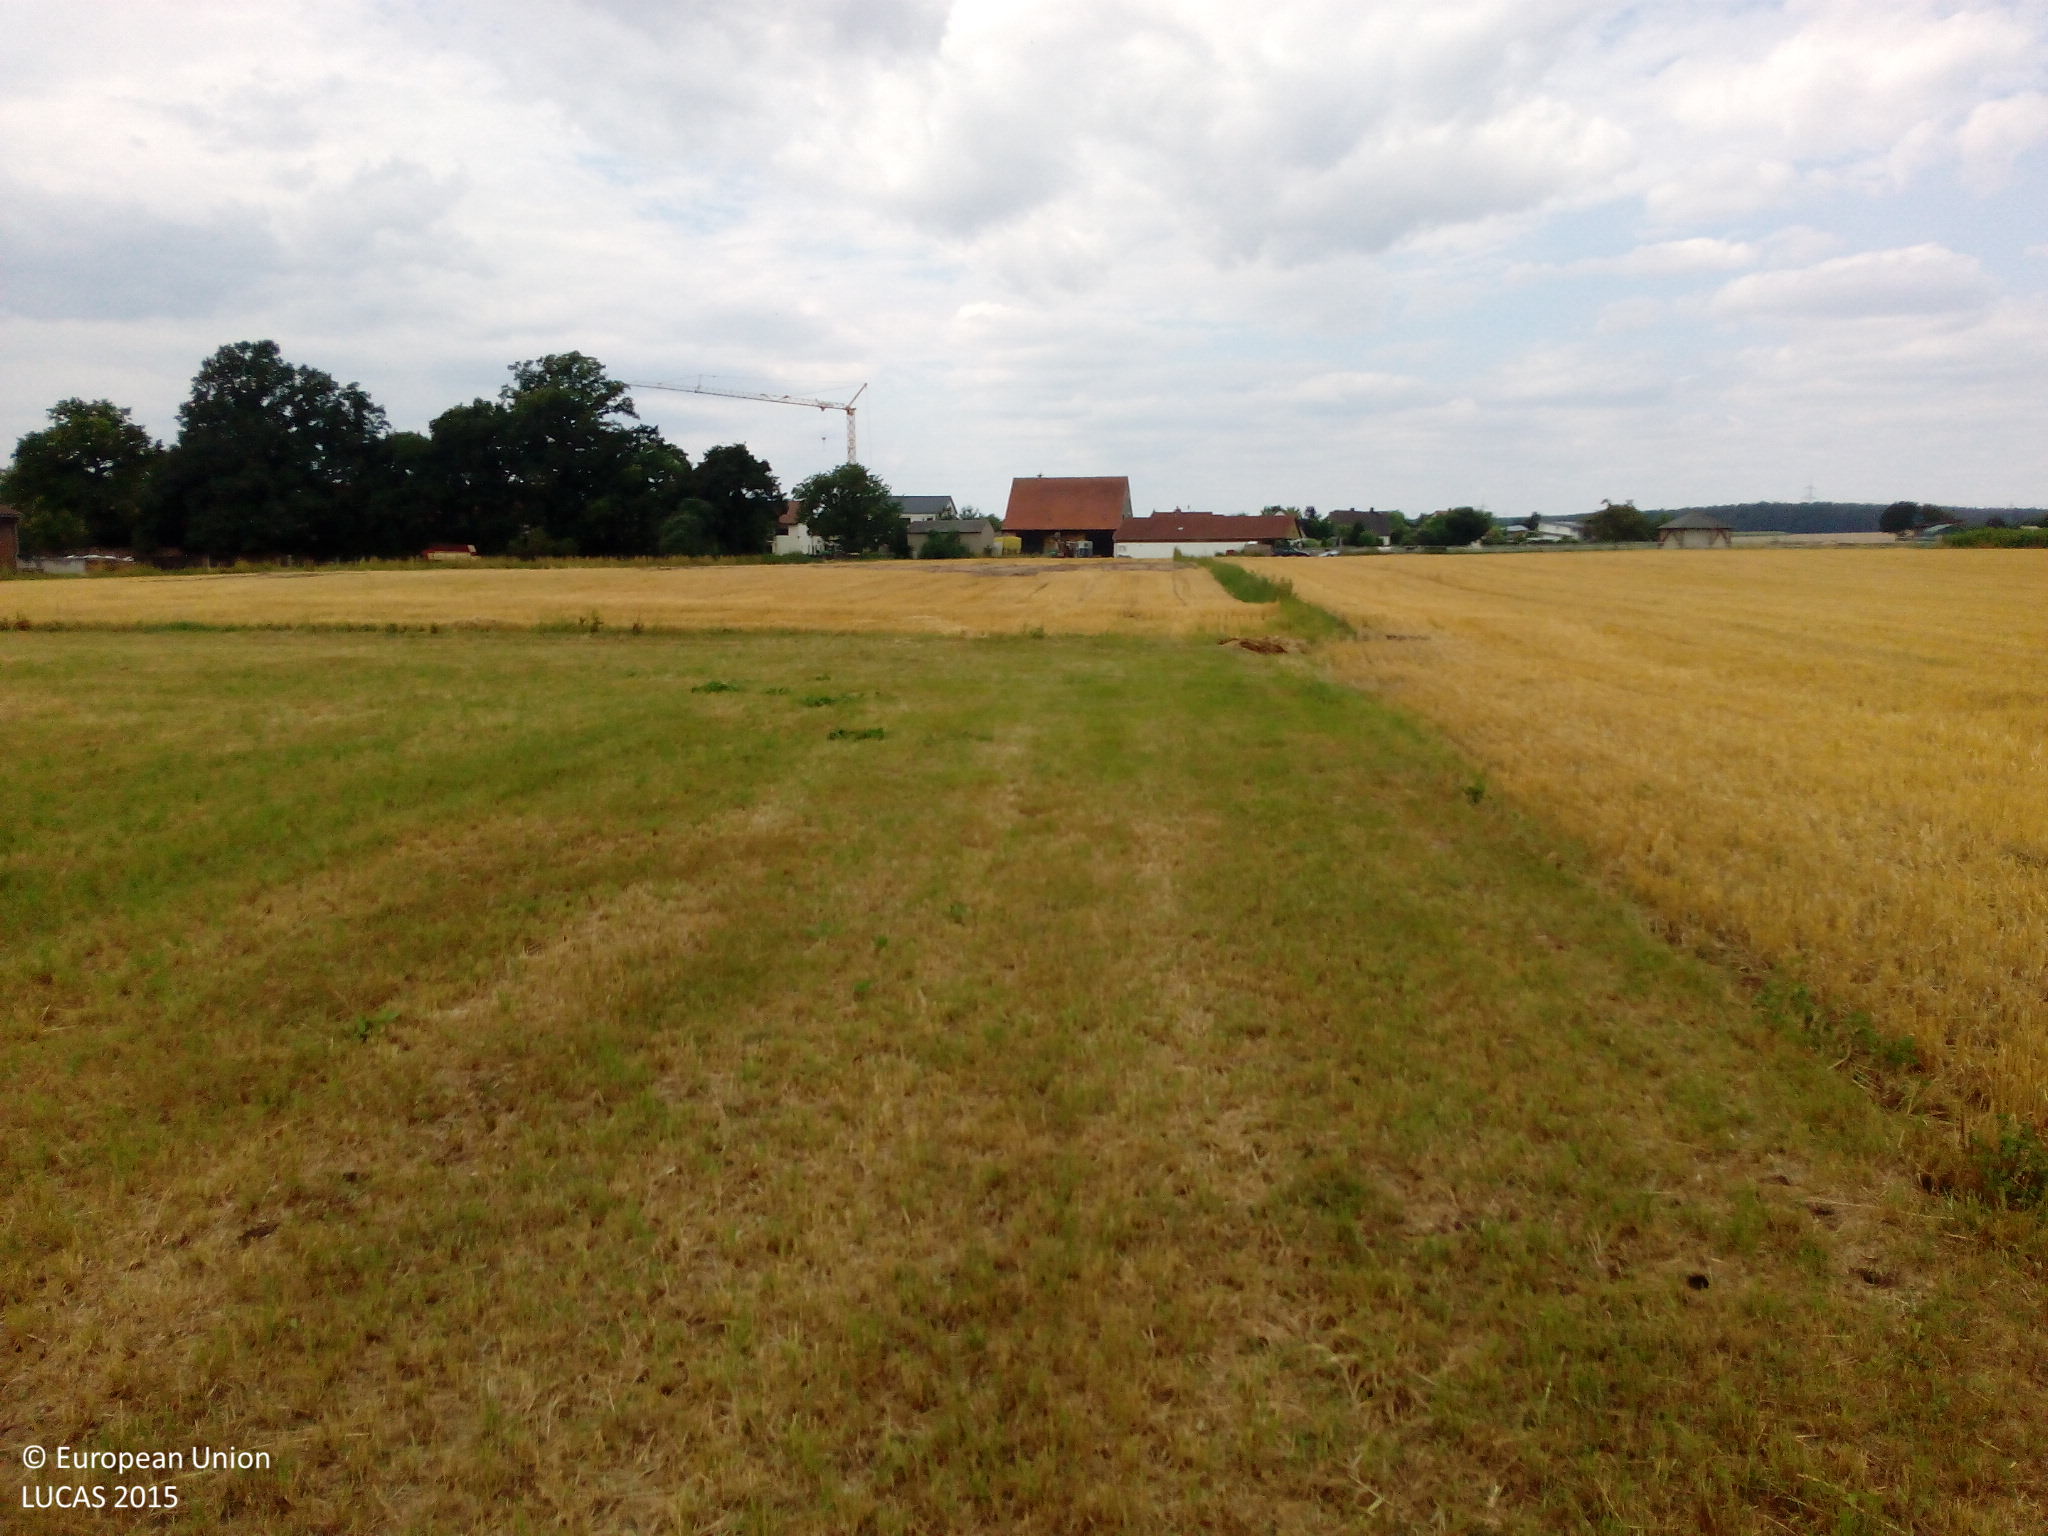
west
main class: Grassland
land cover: Grassland without tree/shrub cover
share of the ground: > 75 %
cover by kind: herbaceous plants 90 %, unconsolidated bare surface 10 %
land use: Agriculture (excluding fallow land and kitchen gardens)
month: July
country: DE
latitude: 49.5330
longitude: 10.9254
